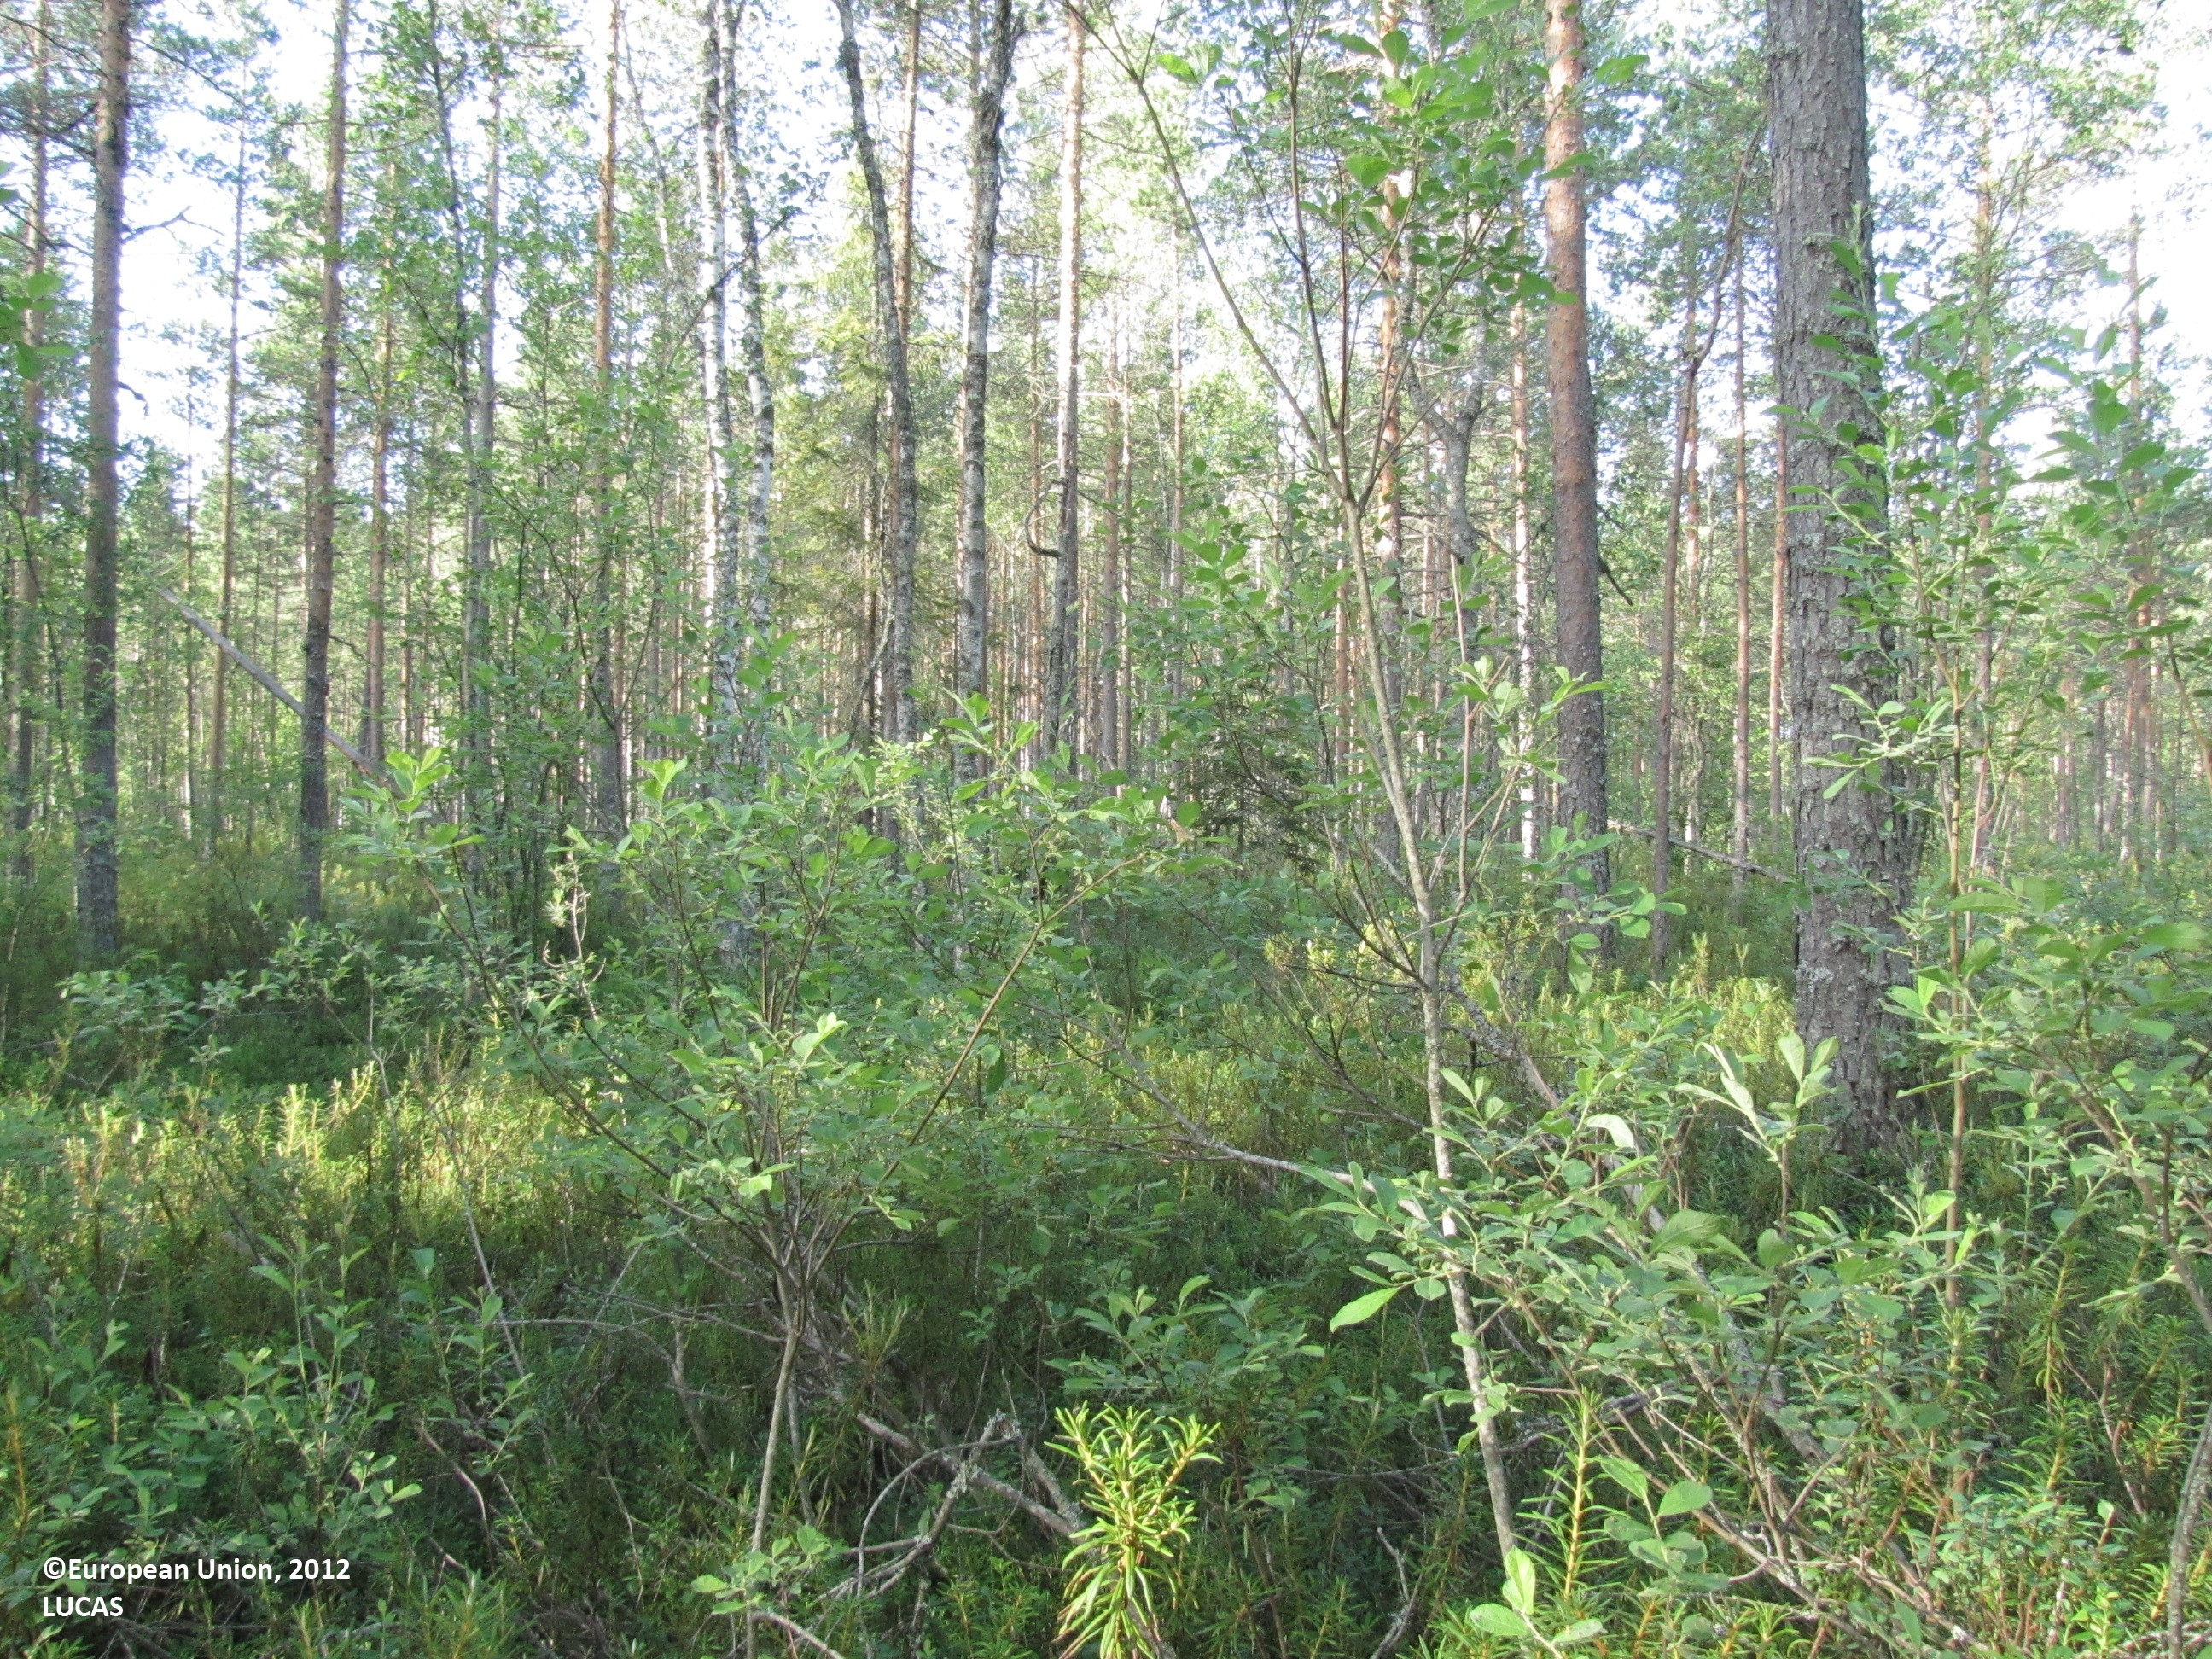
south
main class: Woodland
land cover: Pine dominated coniferous woodland
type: mire and swamp forests
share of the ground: > 75 %
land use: Forestry
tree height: > 5 m
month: July
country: FI
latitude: 62.6062
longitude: 23.2949
